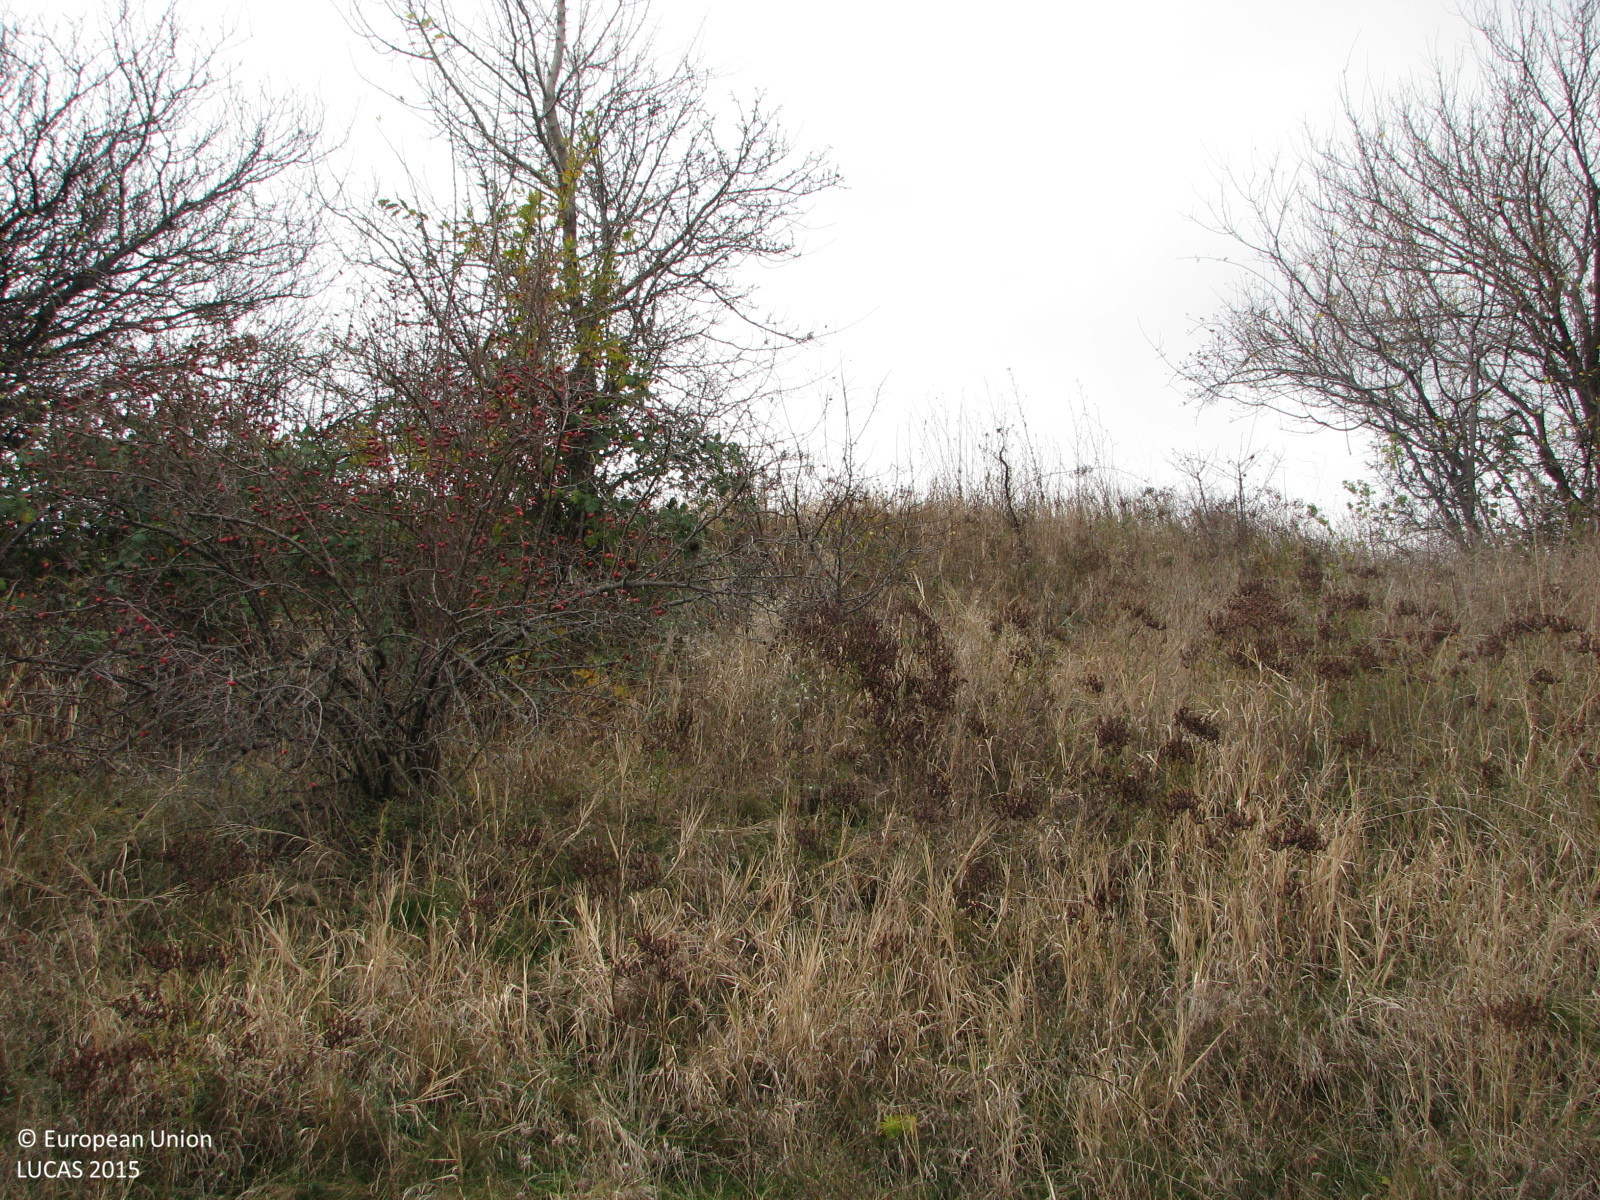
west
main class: Grassland
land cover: Grassland with sparse tree/shrub cover
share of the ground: > 75 %
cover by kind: herbaceous plants 80 %, broadleaved forest trees 5 %, shrubs 5 %, lichens and mosses 5 %, unconsolidated bare surface 5 %
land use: Semi-natural and natural areas not in use
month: December
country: BG
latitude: 42.3304
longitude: 24.0339
